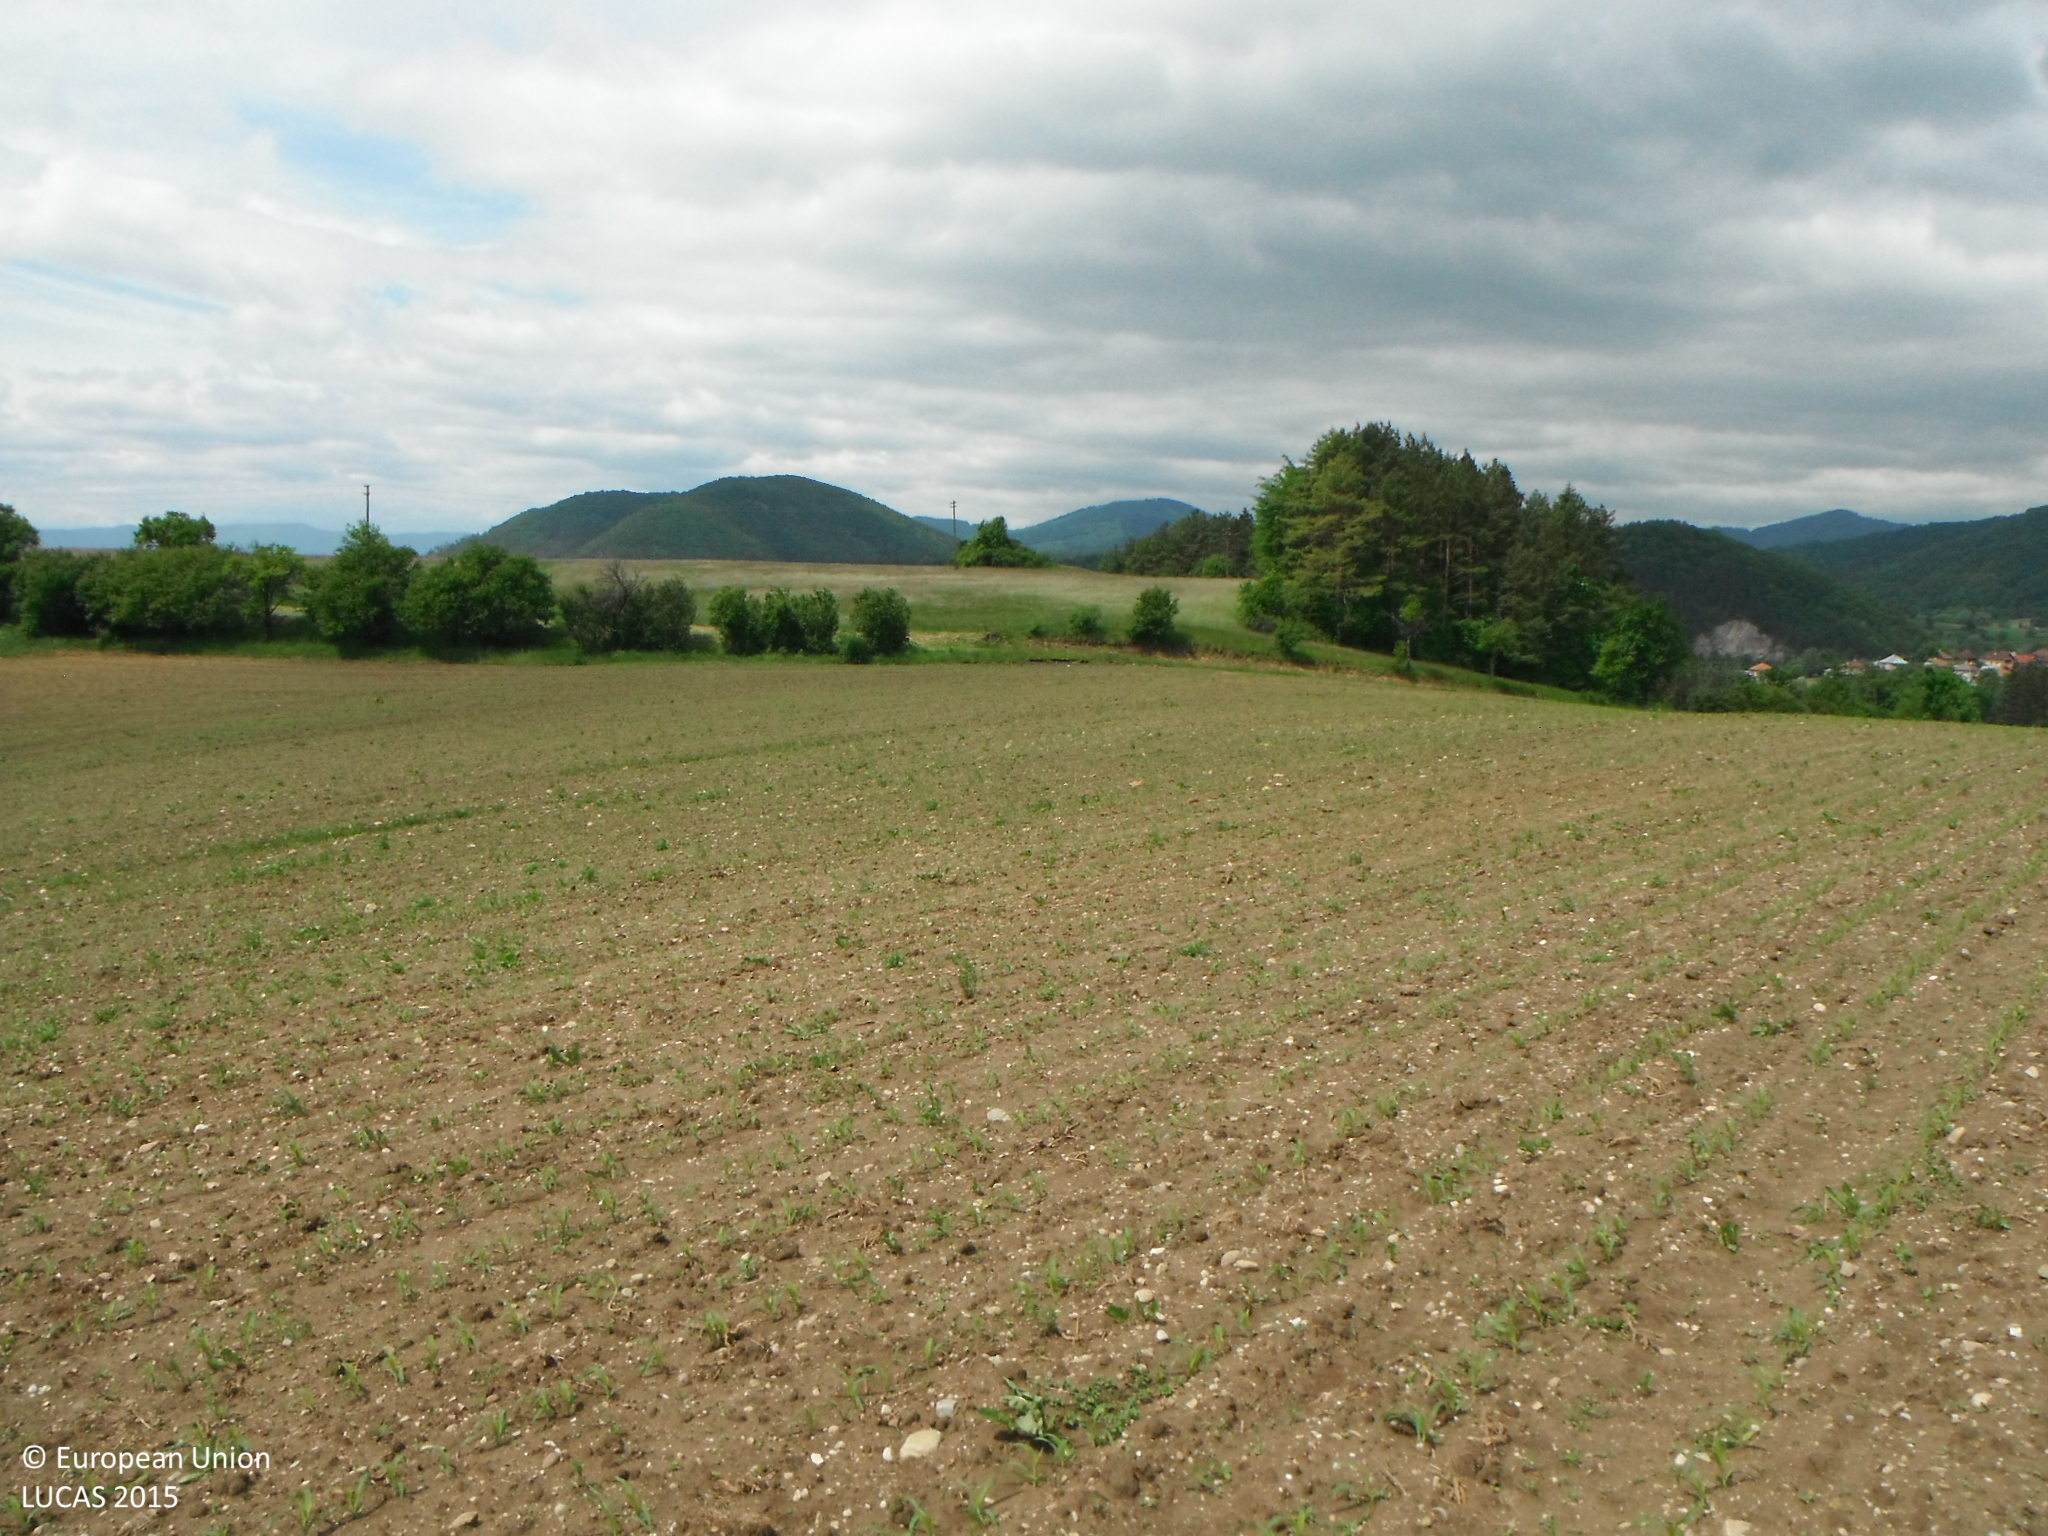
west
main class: Artificial land
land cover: Other artificial areas
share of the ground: > 75 %
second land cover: Maize
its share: < 10 %
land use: Electricity, gas and thermal power distribution
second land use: Agriculture (excluding fallow land and kitchen gardens)
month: May
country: SK
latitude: 48.7923
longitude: 19.2661
